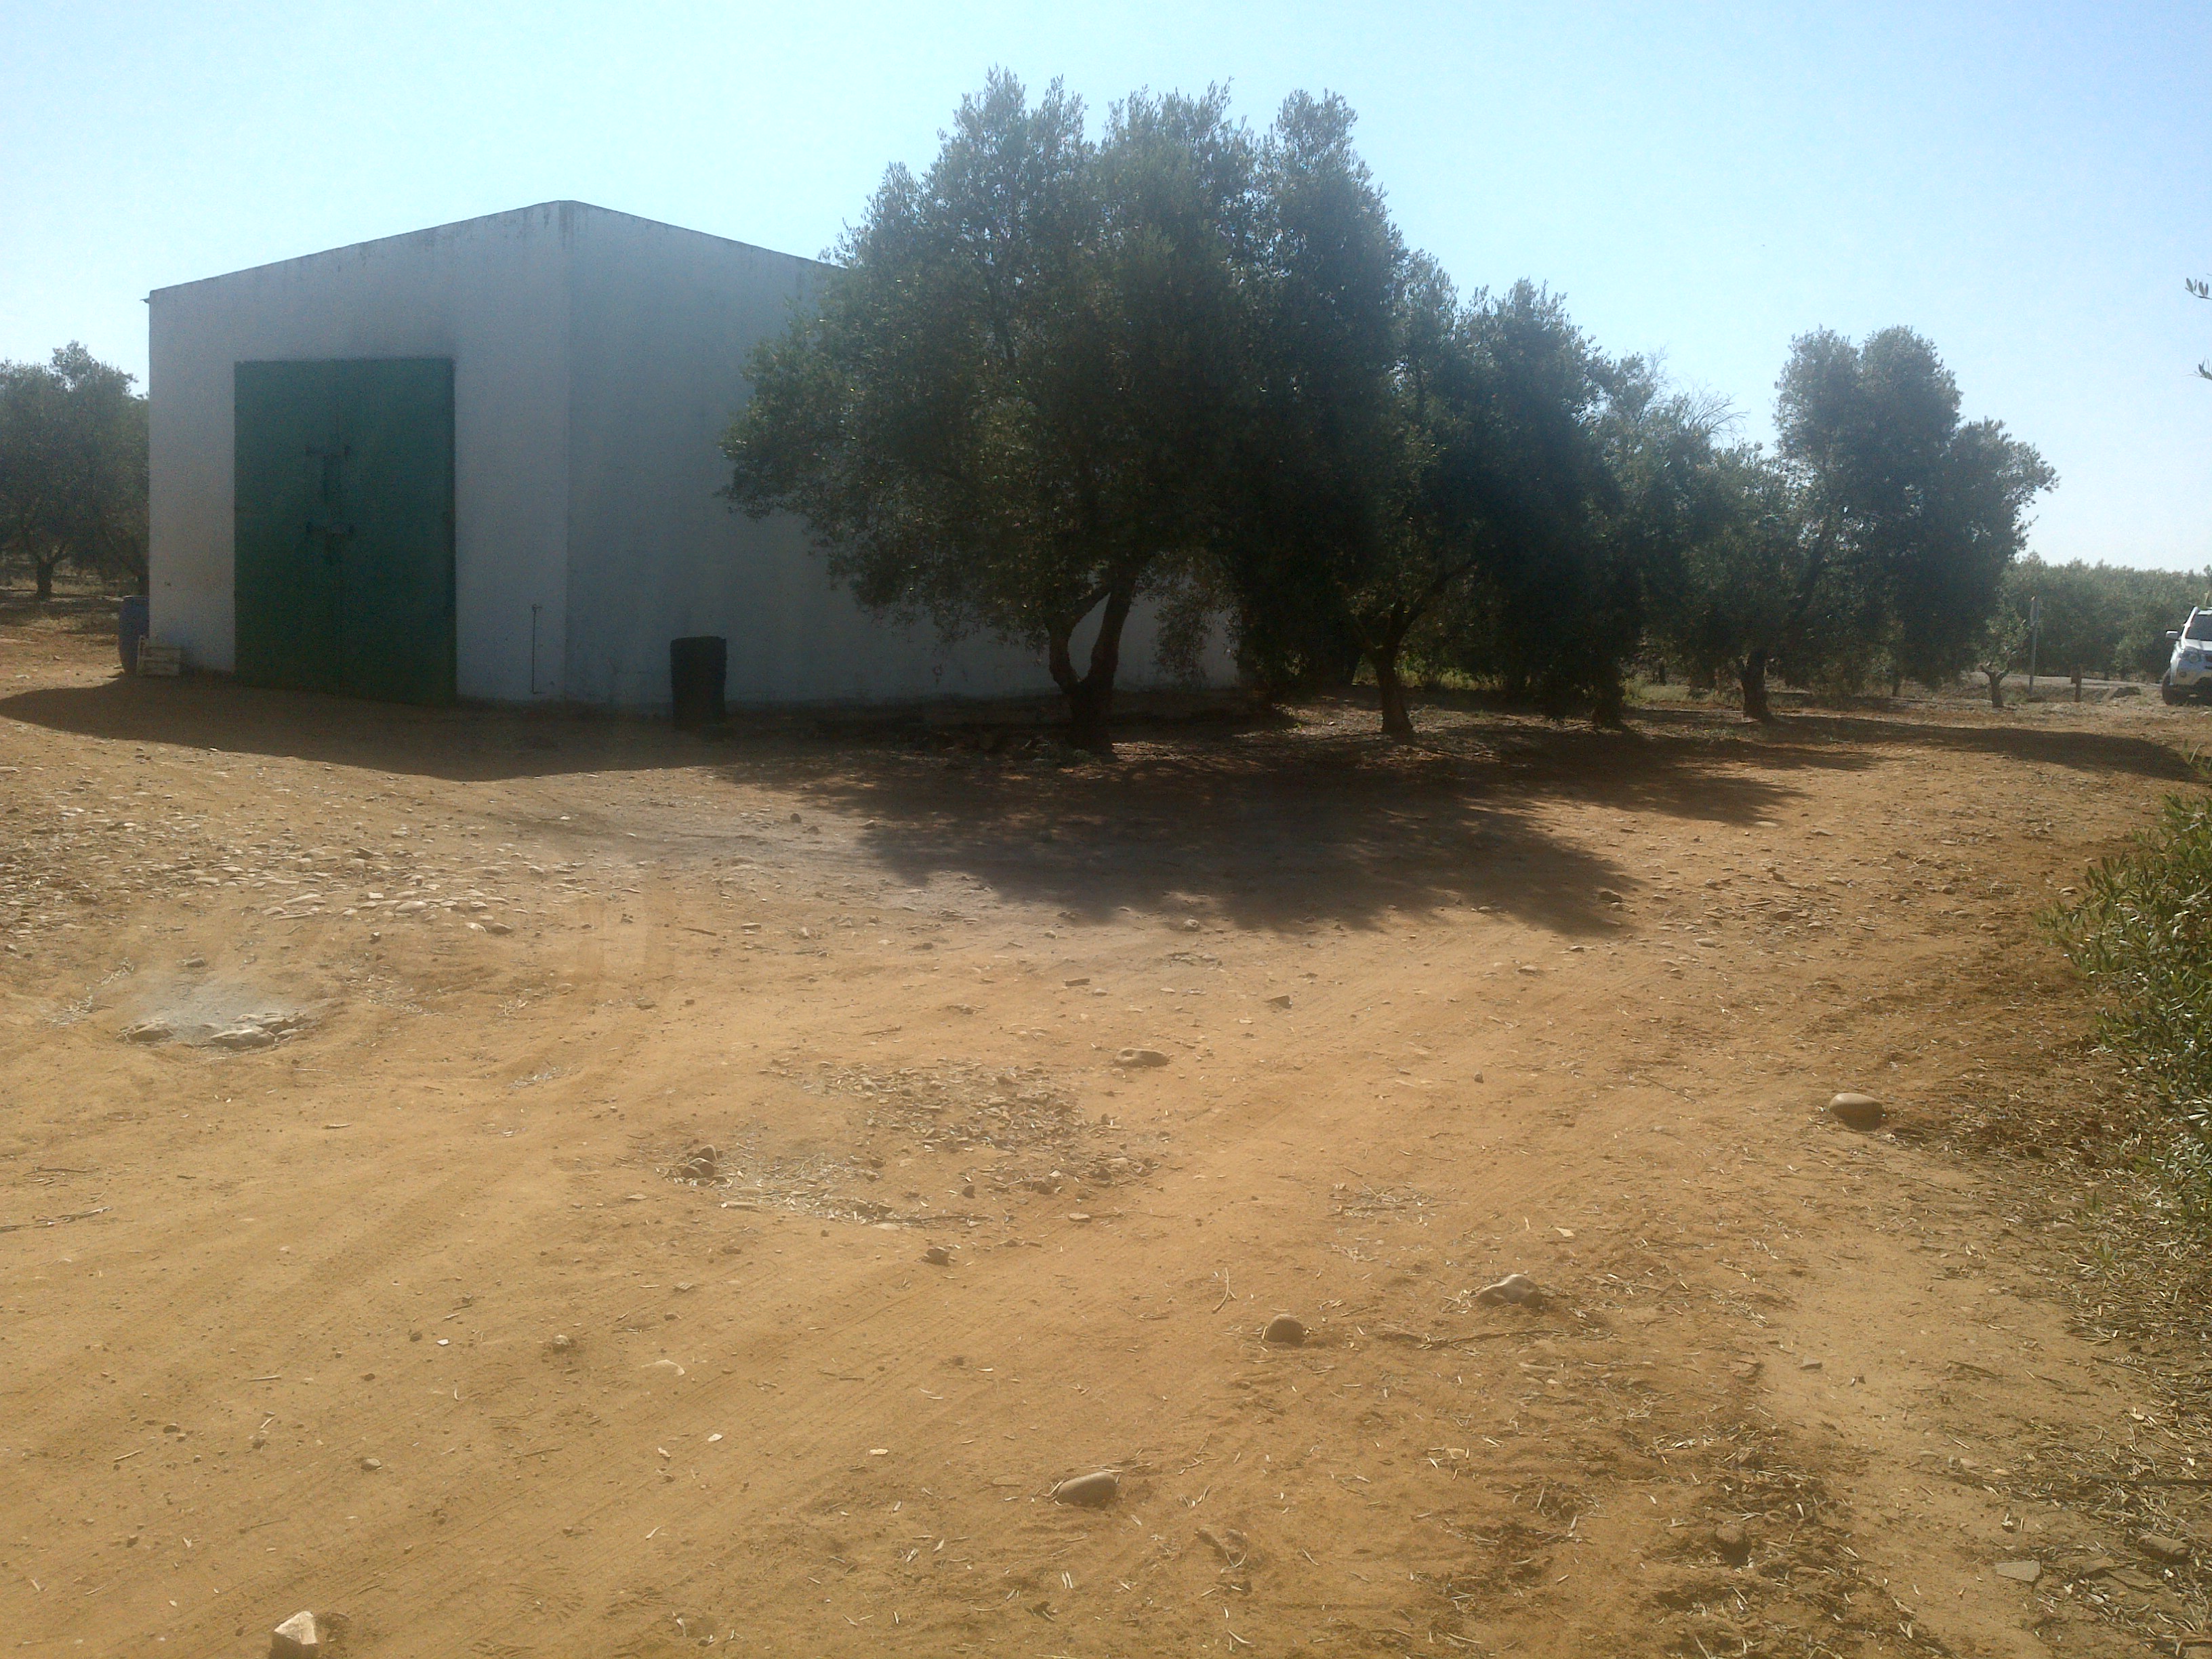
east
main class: Cropland
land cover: Olive groves
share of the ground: 50 - 75 %
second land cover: Other bare soil
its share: > 75 %
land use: Agriculture (excluding fallow land and kitchen gardens)
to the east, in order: Olive groves; Other bare soil; Artificial constructions in urban areas; Olive groves; Paved roads, cycling and walking lanes; Grass margins; Olive groves; Tracks; Olive groves
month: June
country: ES
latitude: 37.6814
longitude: -5.1767
